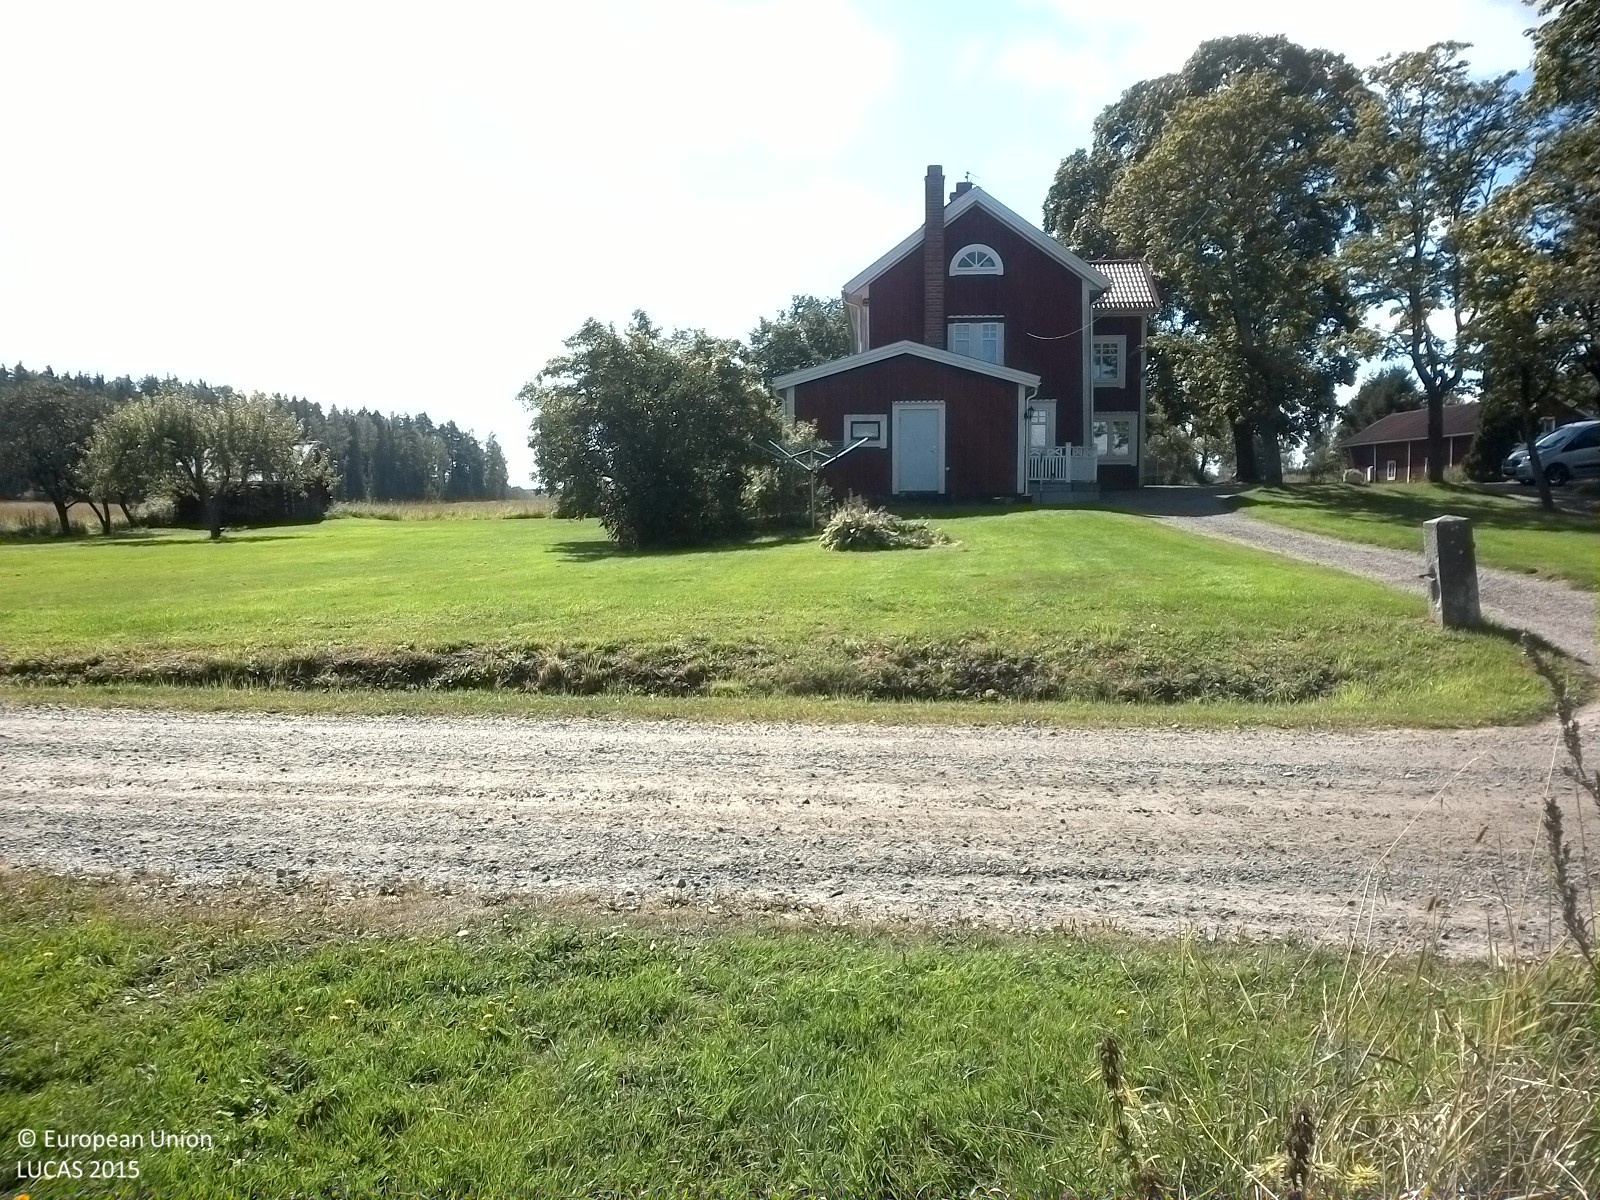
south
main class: Grassland
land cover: Spontaneously vegetated surfaces
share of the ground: > 75 %
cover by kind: herbaceous plants 100 %
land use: Residential
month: August
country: SE
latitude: 59.4702
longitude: 15.2327
